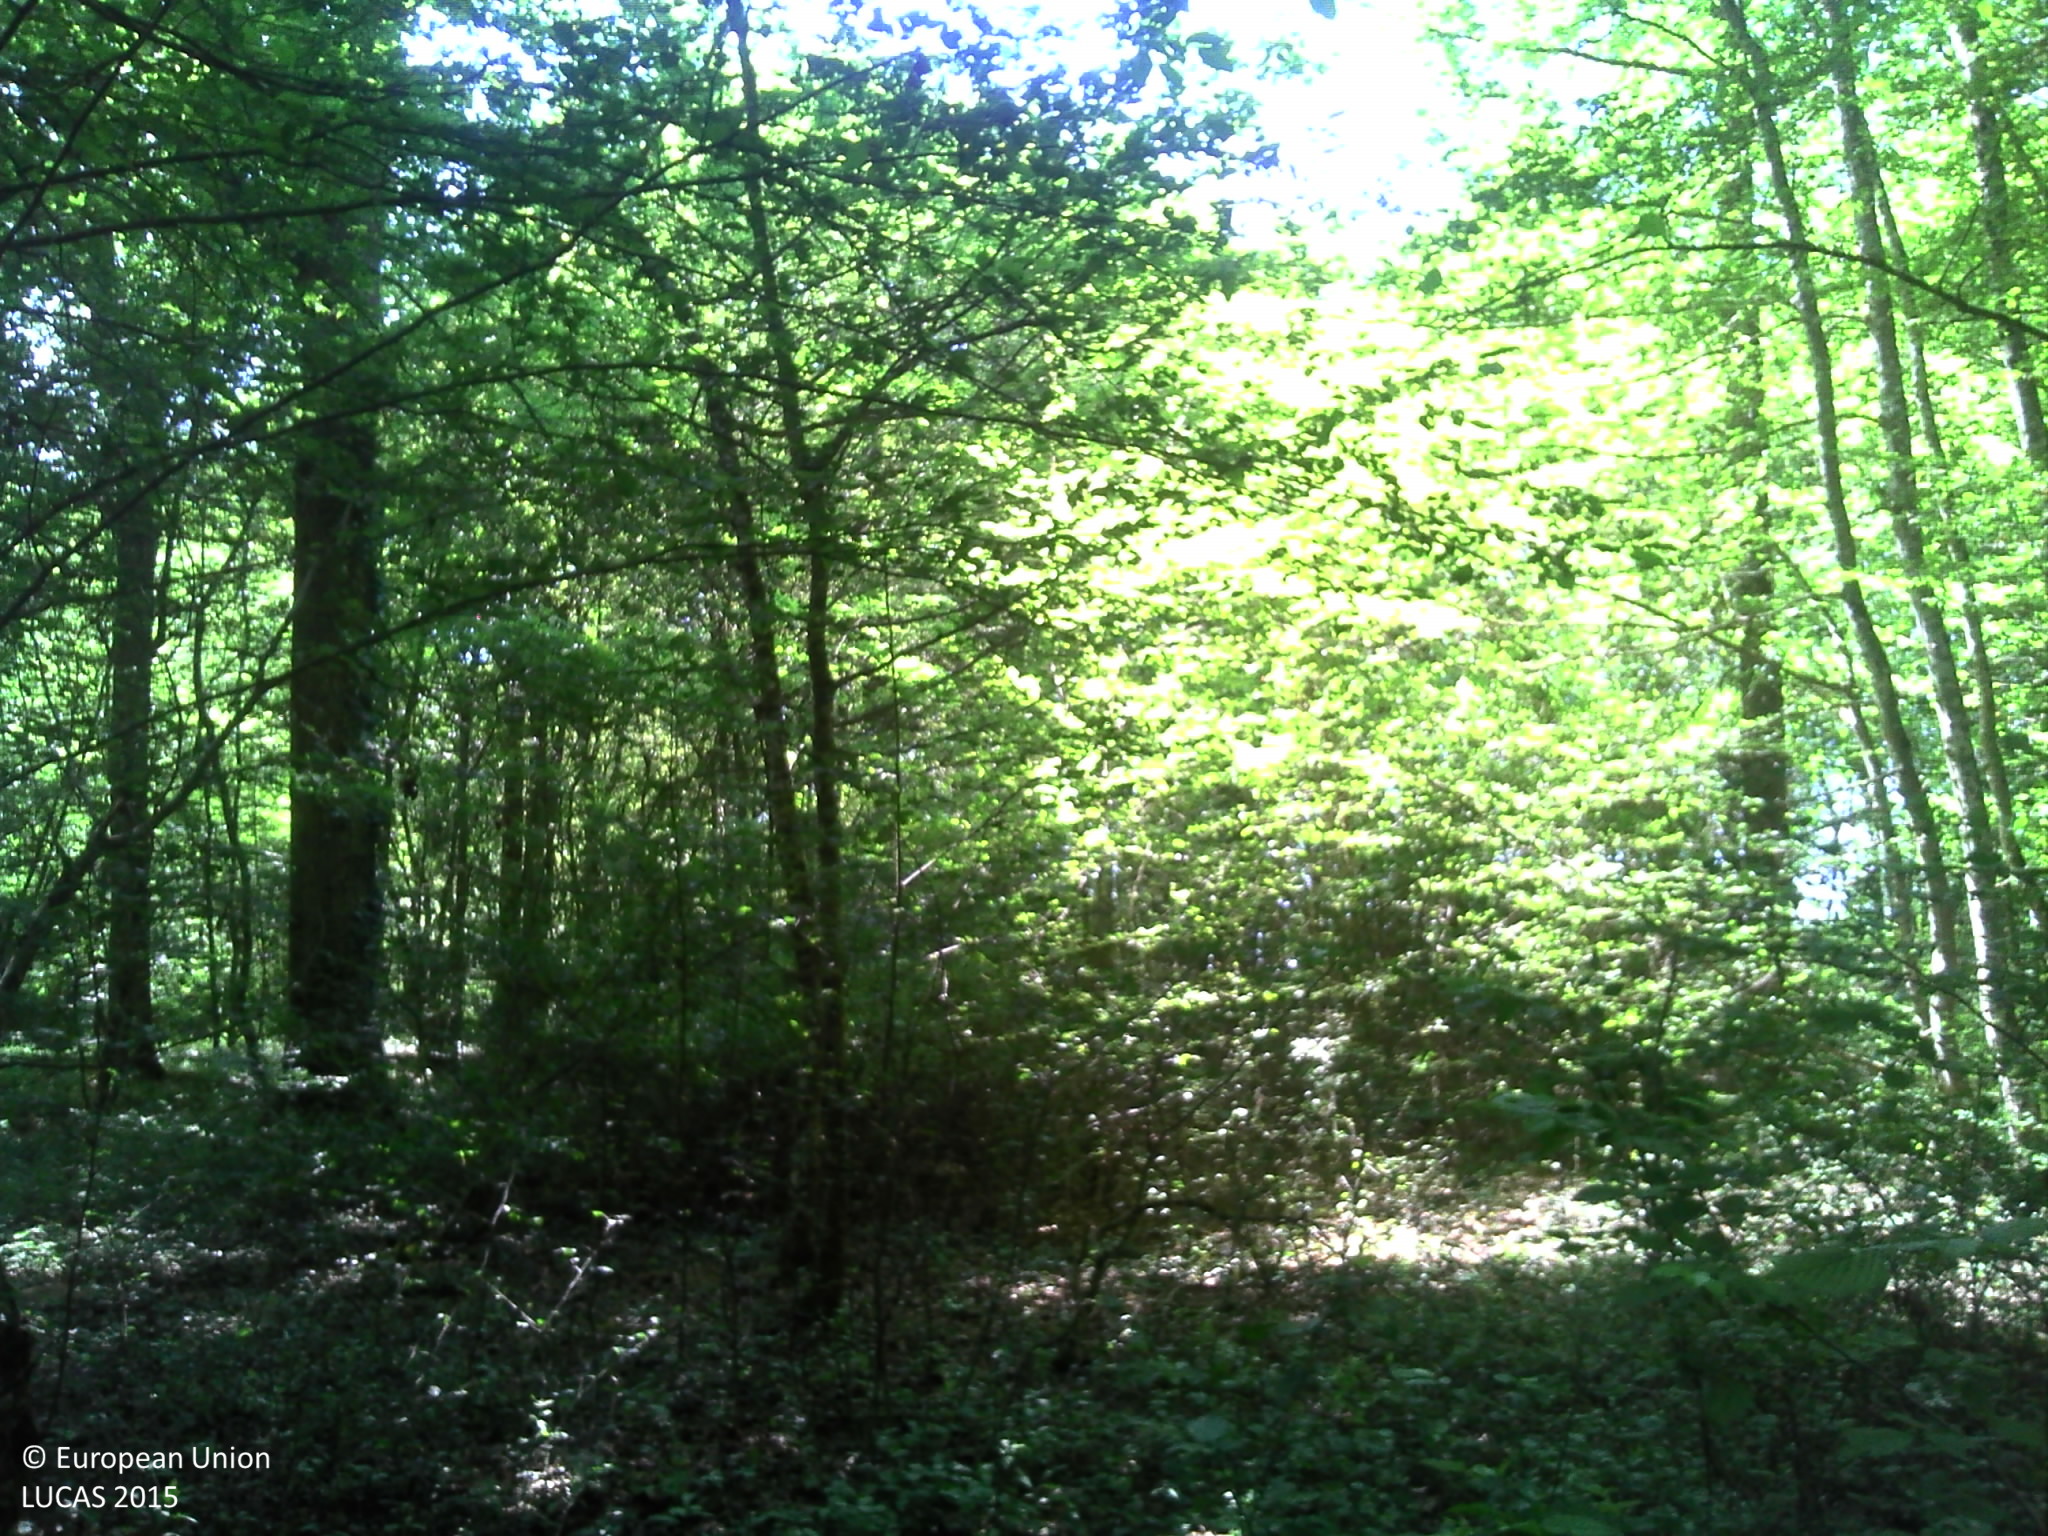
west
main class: Woodland
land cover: Broadleaved woodland
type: mesophytic deciduous forest
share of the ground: > 75 %
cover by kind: broadleaved forest trees 95 %, herbaceous plants 5 %
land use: Forestry
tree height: > 5 m
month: June
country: FR
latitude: 47.7516
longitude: 2.5082
